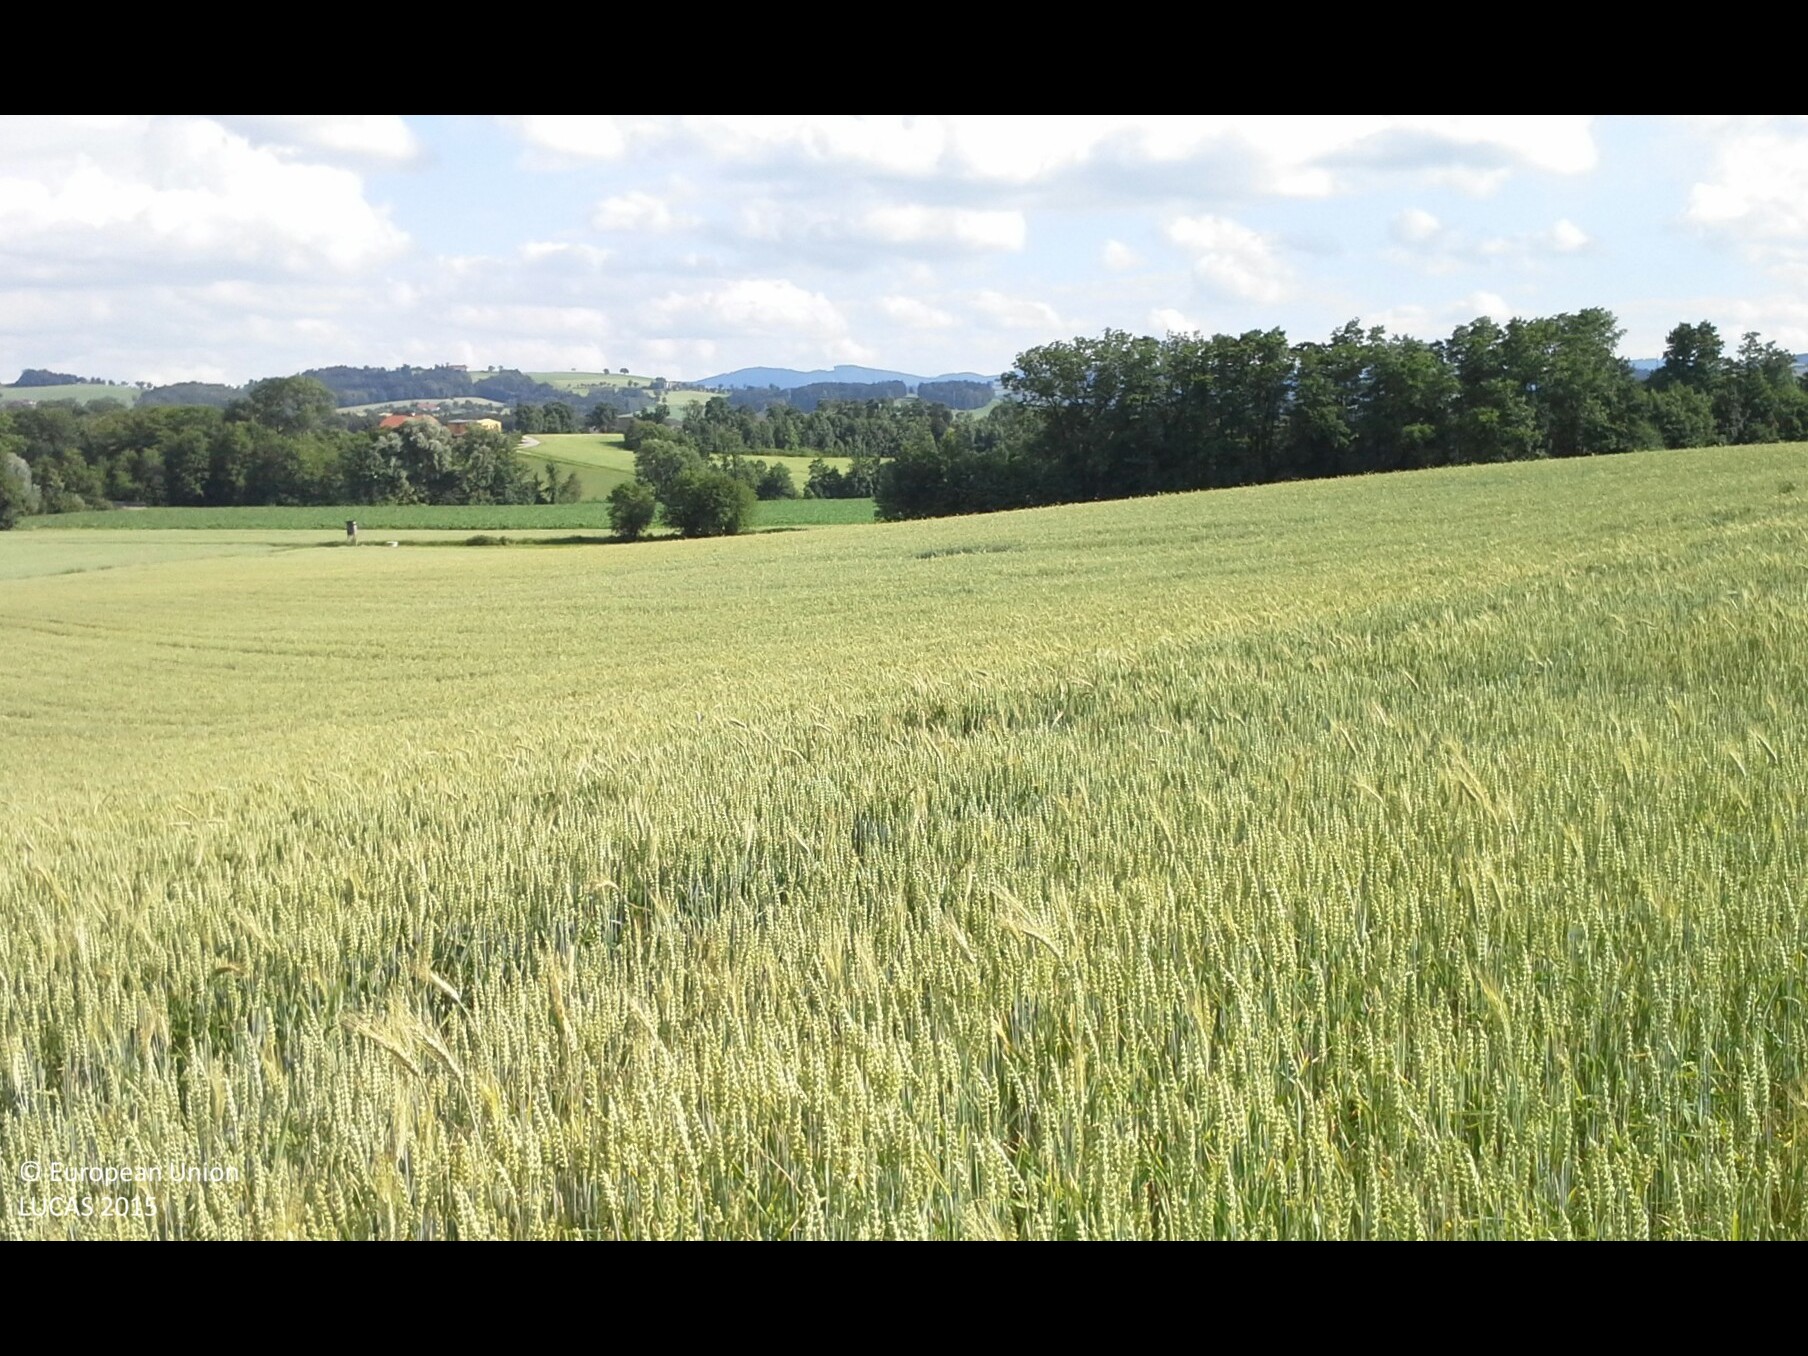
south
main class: Cropland
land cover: Common wheat
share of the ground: > 75 %
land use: Agriculture (excluding fallow land and kitchen gardens)
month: June
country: AT
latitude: 48.0509
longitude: 14.7093
